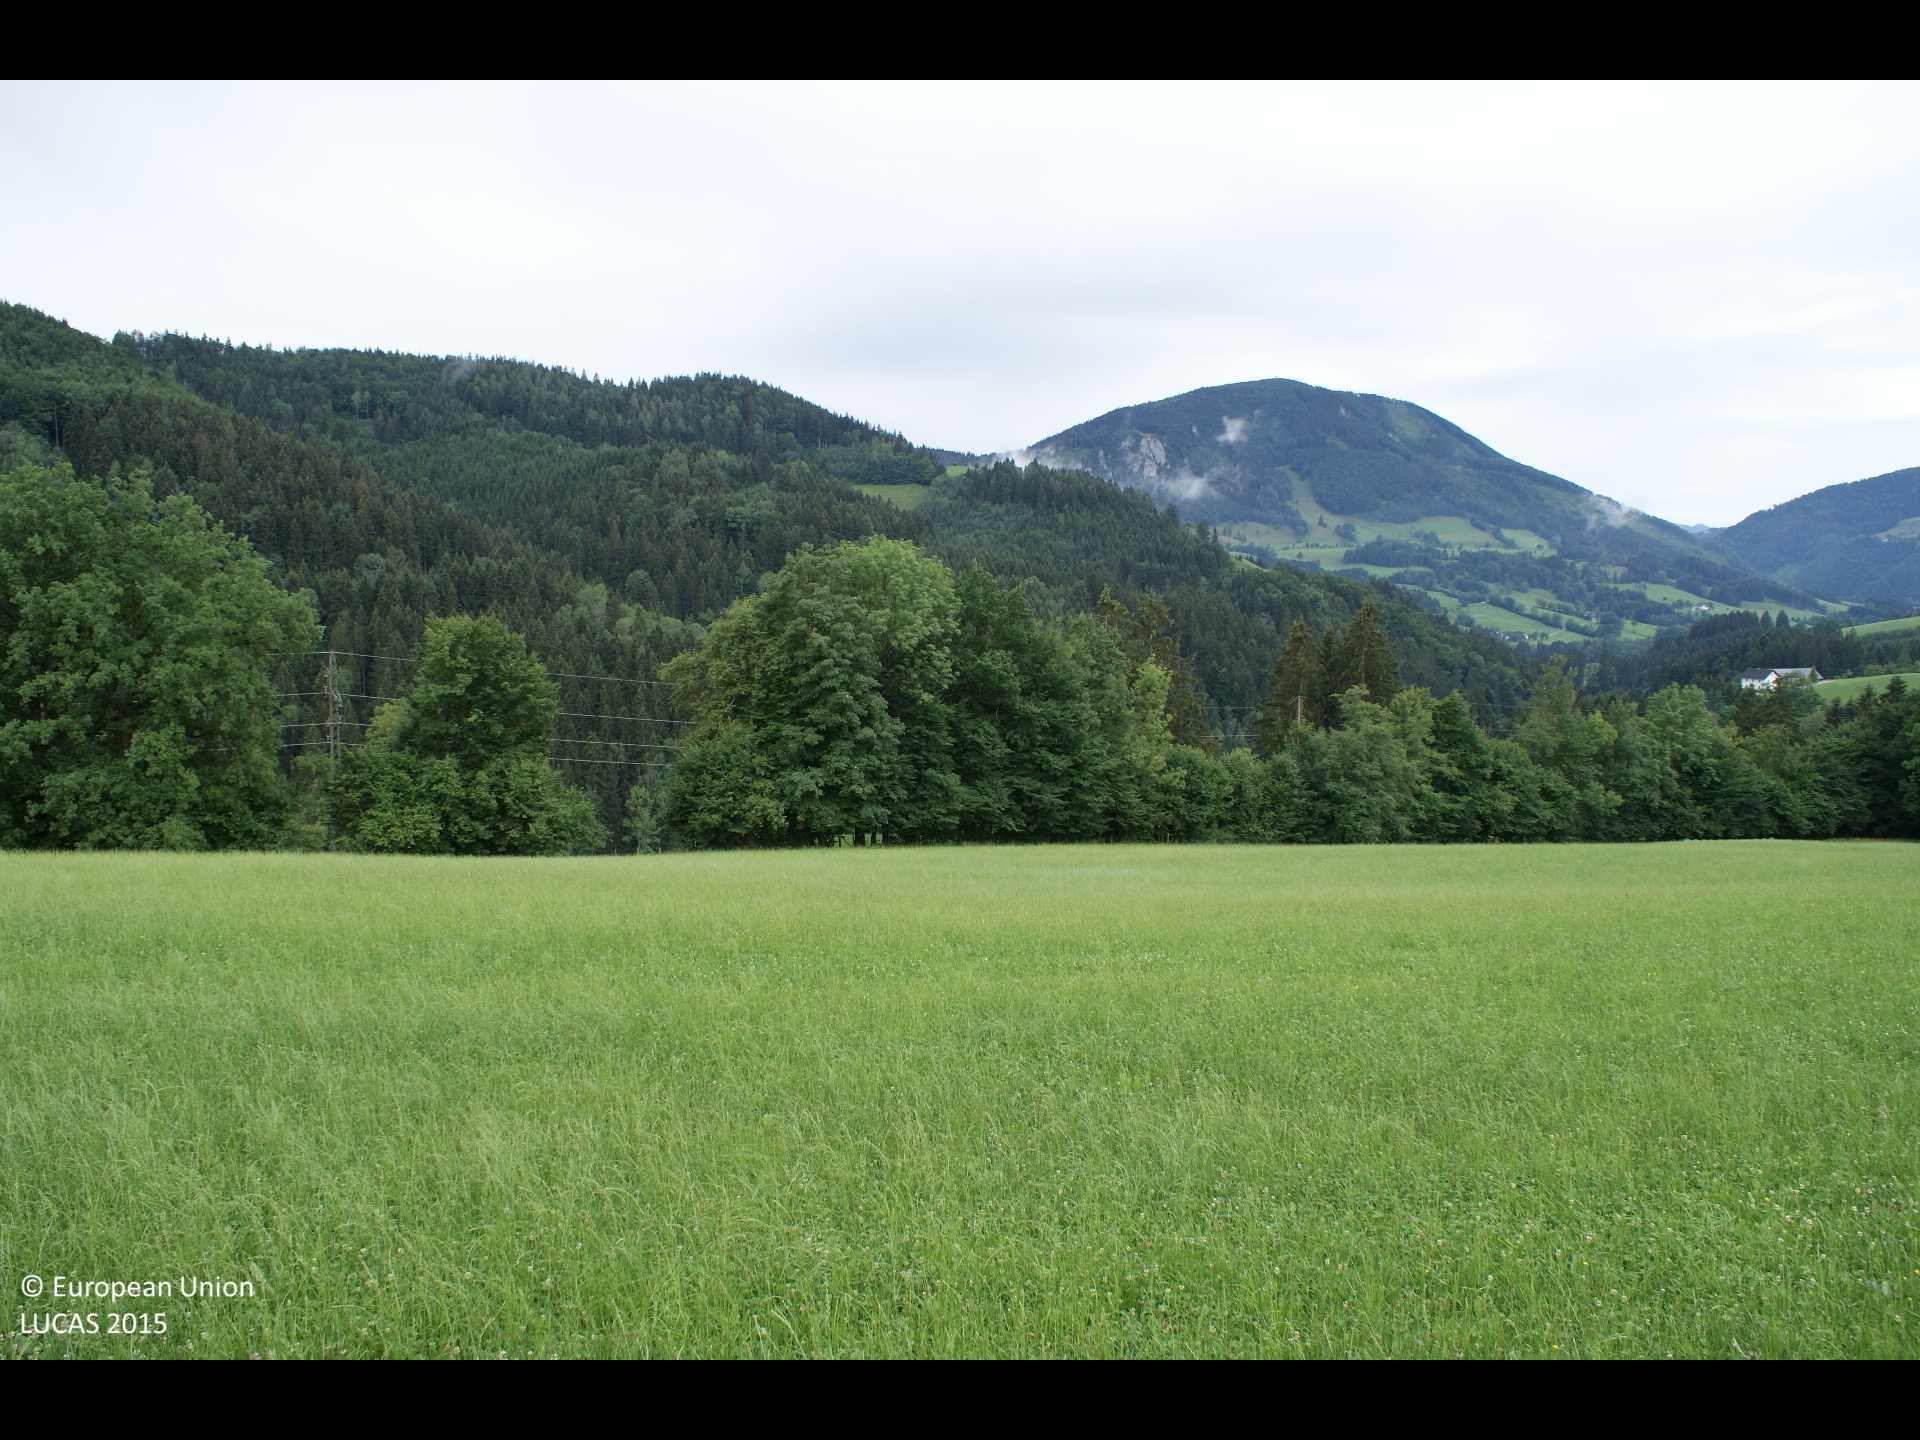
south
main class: Grassland
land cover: Grassland without tree/shrub cover
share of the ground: > 75 %
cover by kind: herbaceous plants 100 %
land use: Agriculture (excluding fallow land and kitchen gardens)
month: July
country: AT
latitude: 47.9685
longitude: 14.9432
